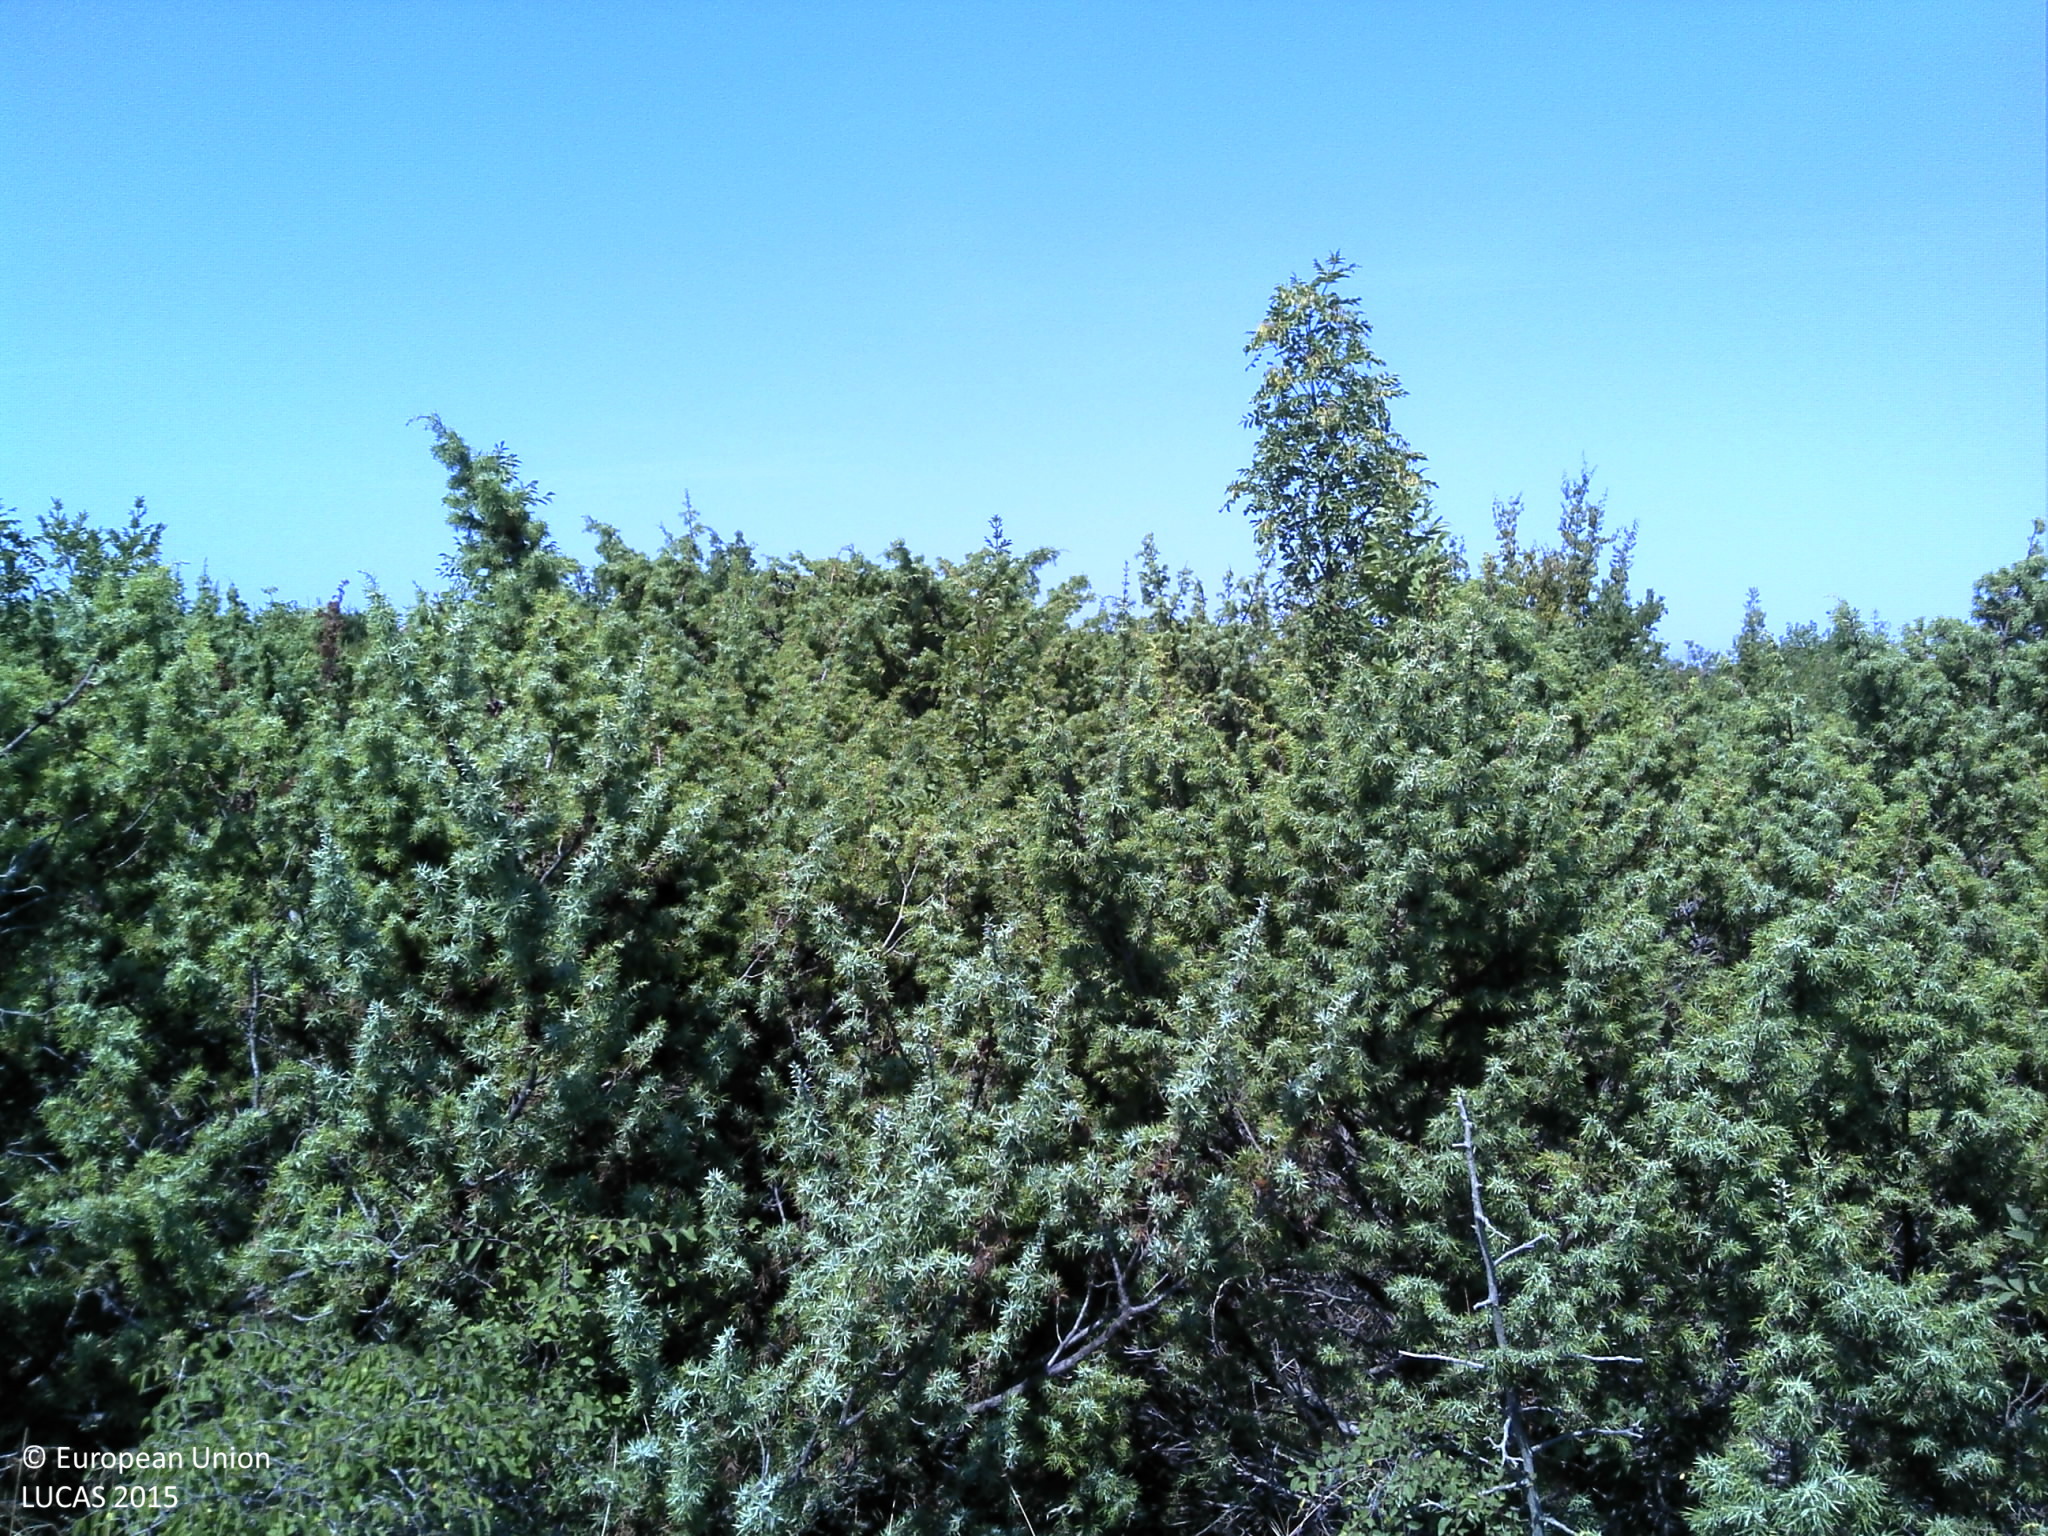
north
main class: Shrubland
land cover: Shrubland with sparse tree cover
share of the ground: > 75 %
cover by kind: shrubs 80 %, consolidated bare surface 10 %, coniferous forest trees 5 %, herbaceous plants 5 %
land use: Semi-natural and natural areas not in use
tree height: < 5 m
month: August
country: HR
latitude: 43.9996
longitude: 15.6161
